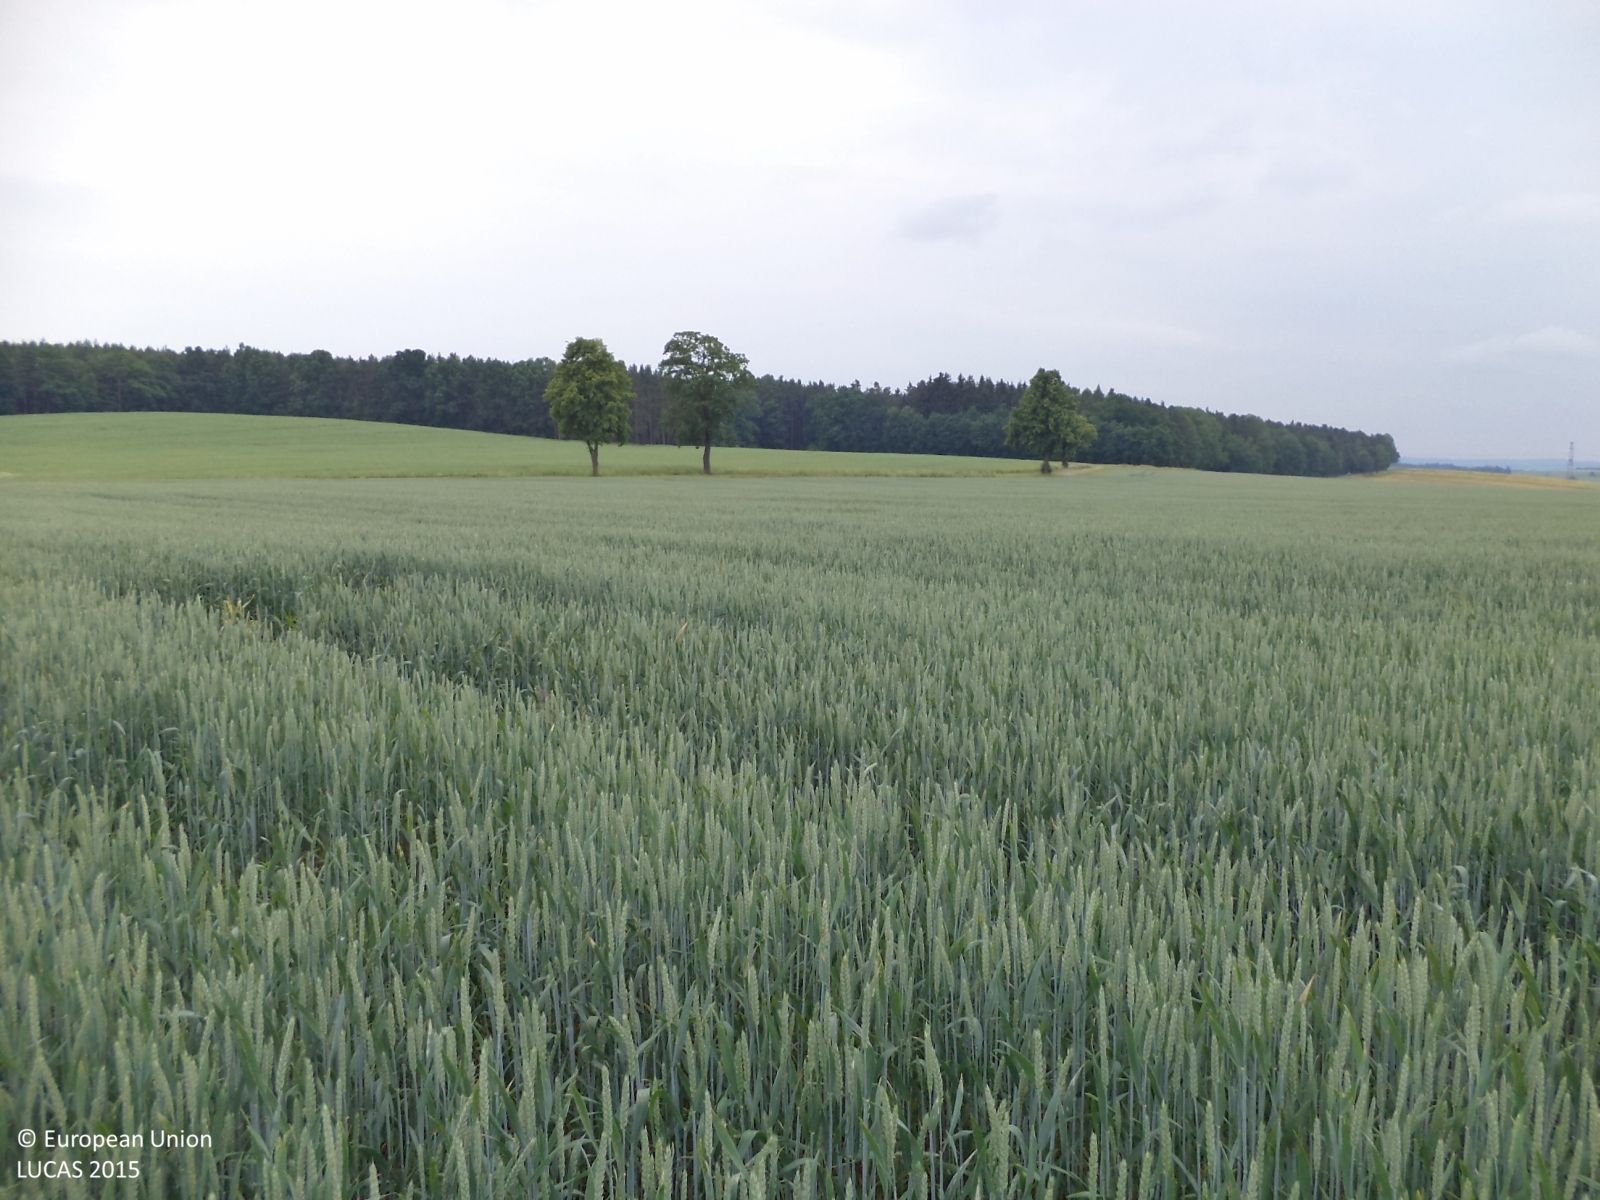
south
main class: Cropland
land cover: Common wheat
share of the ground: > 75 %
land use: Agriculture (excluding fallow land and kitchen gardens)
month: June
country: CZ
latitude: 49.1859
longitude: 14.2679
